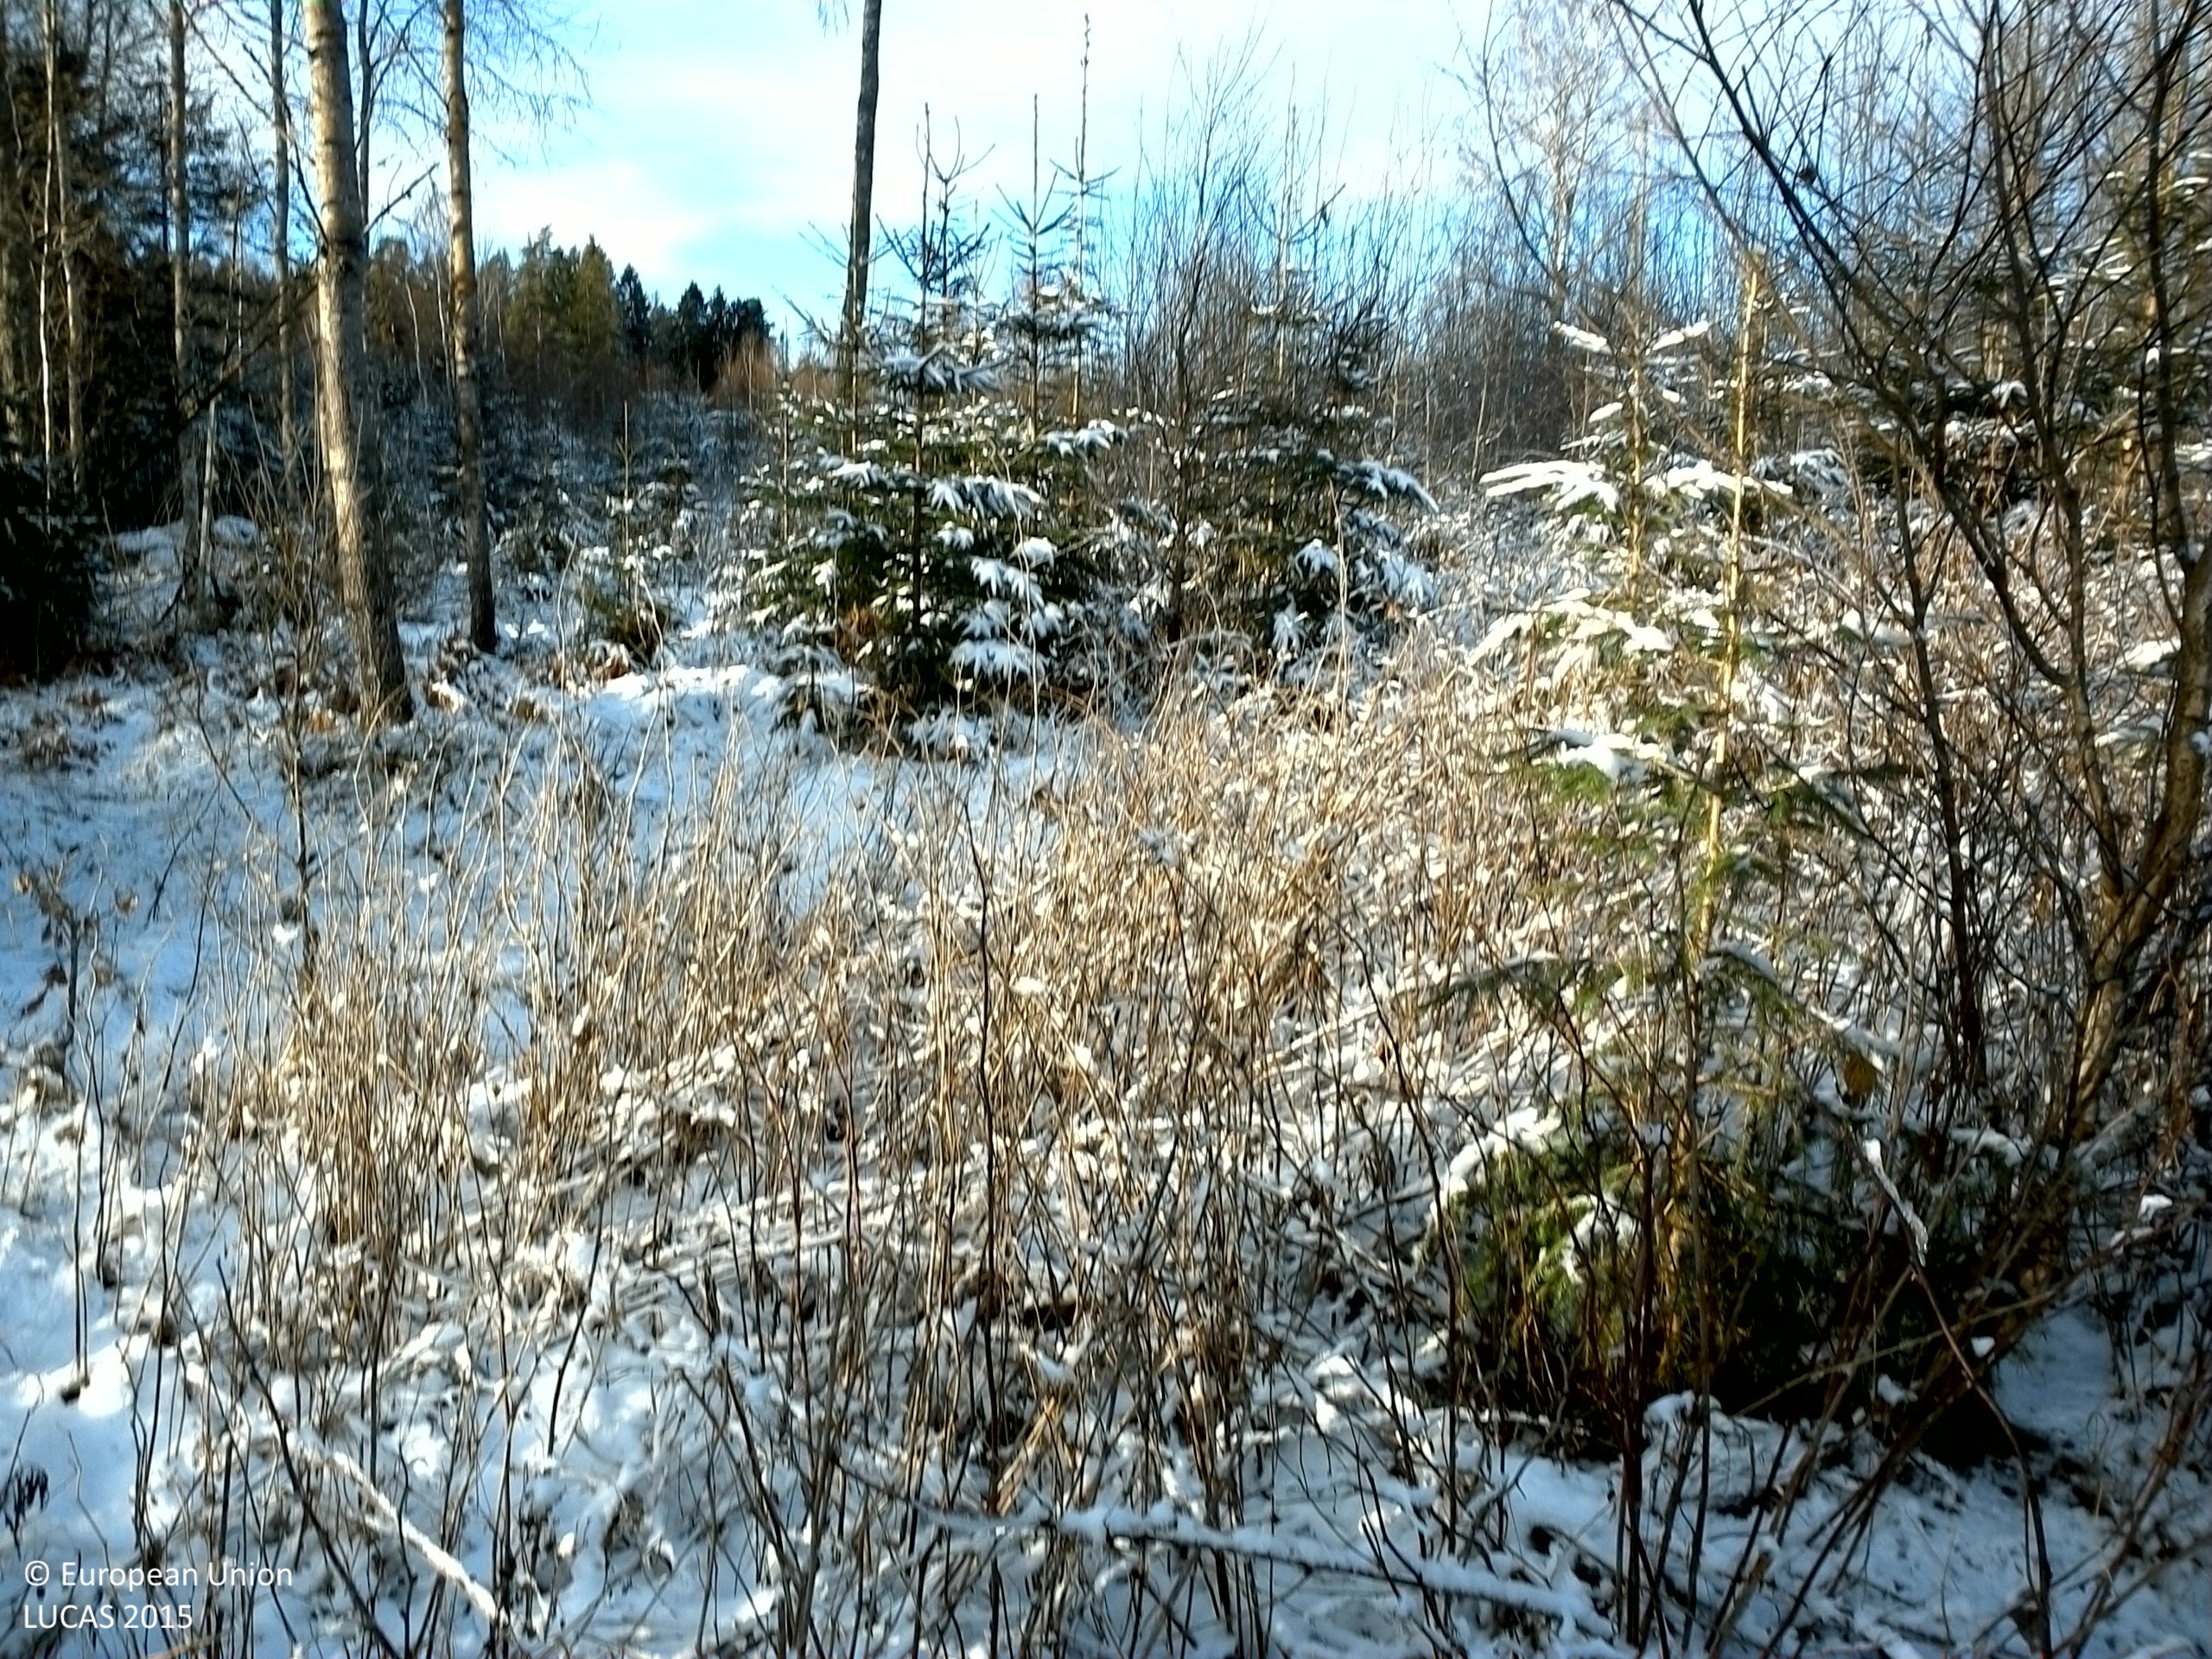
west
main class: Woodland
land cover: Spruce dominated mixed woodland
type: boreal forest
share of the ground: 50 - 75 %
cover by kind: broadleaved forest trees 40 %, shrubs 30 %, coniferous forest trees 20 %, herbaceous plants 10 %
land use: Forestry
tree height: > 5 m
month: December
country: SE
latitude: 59.6854
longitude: 16.5460
